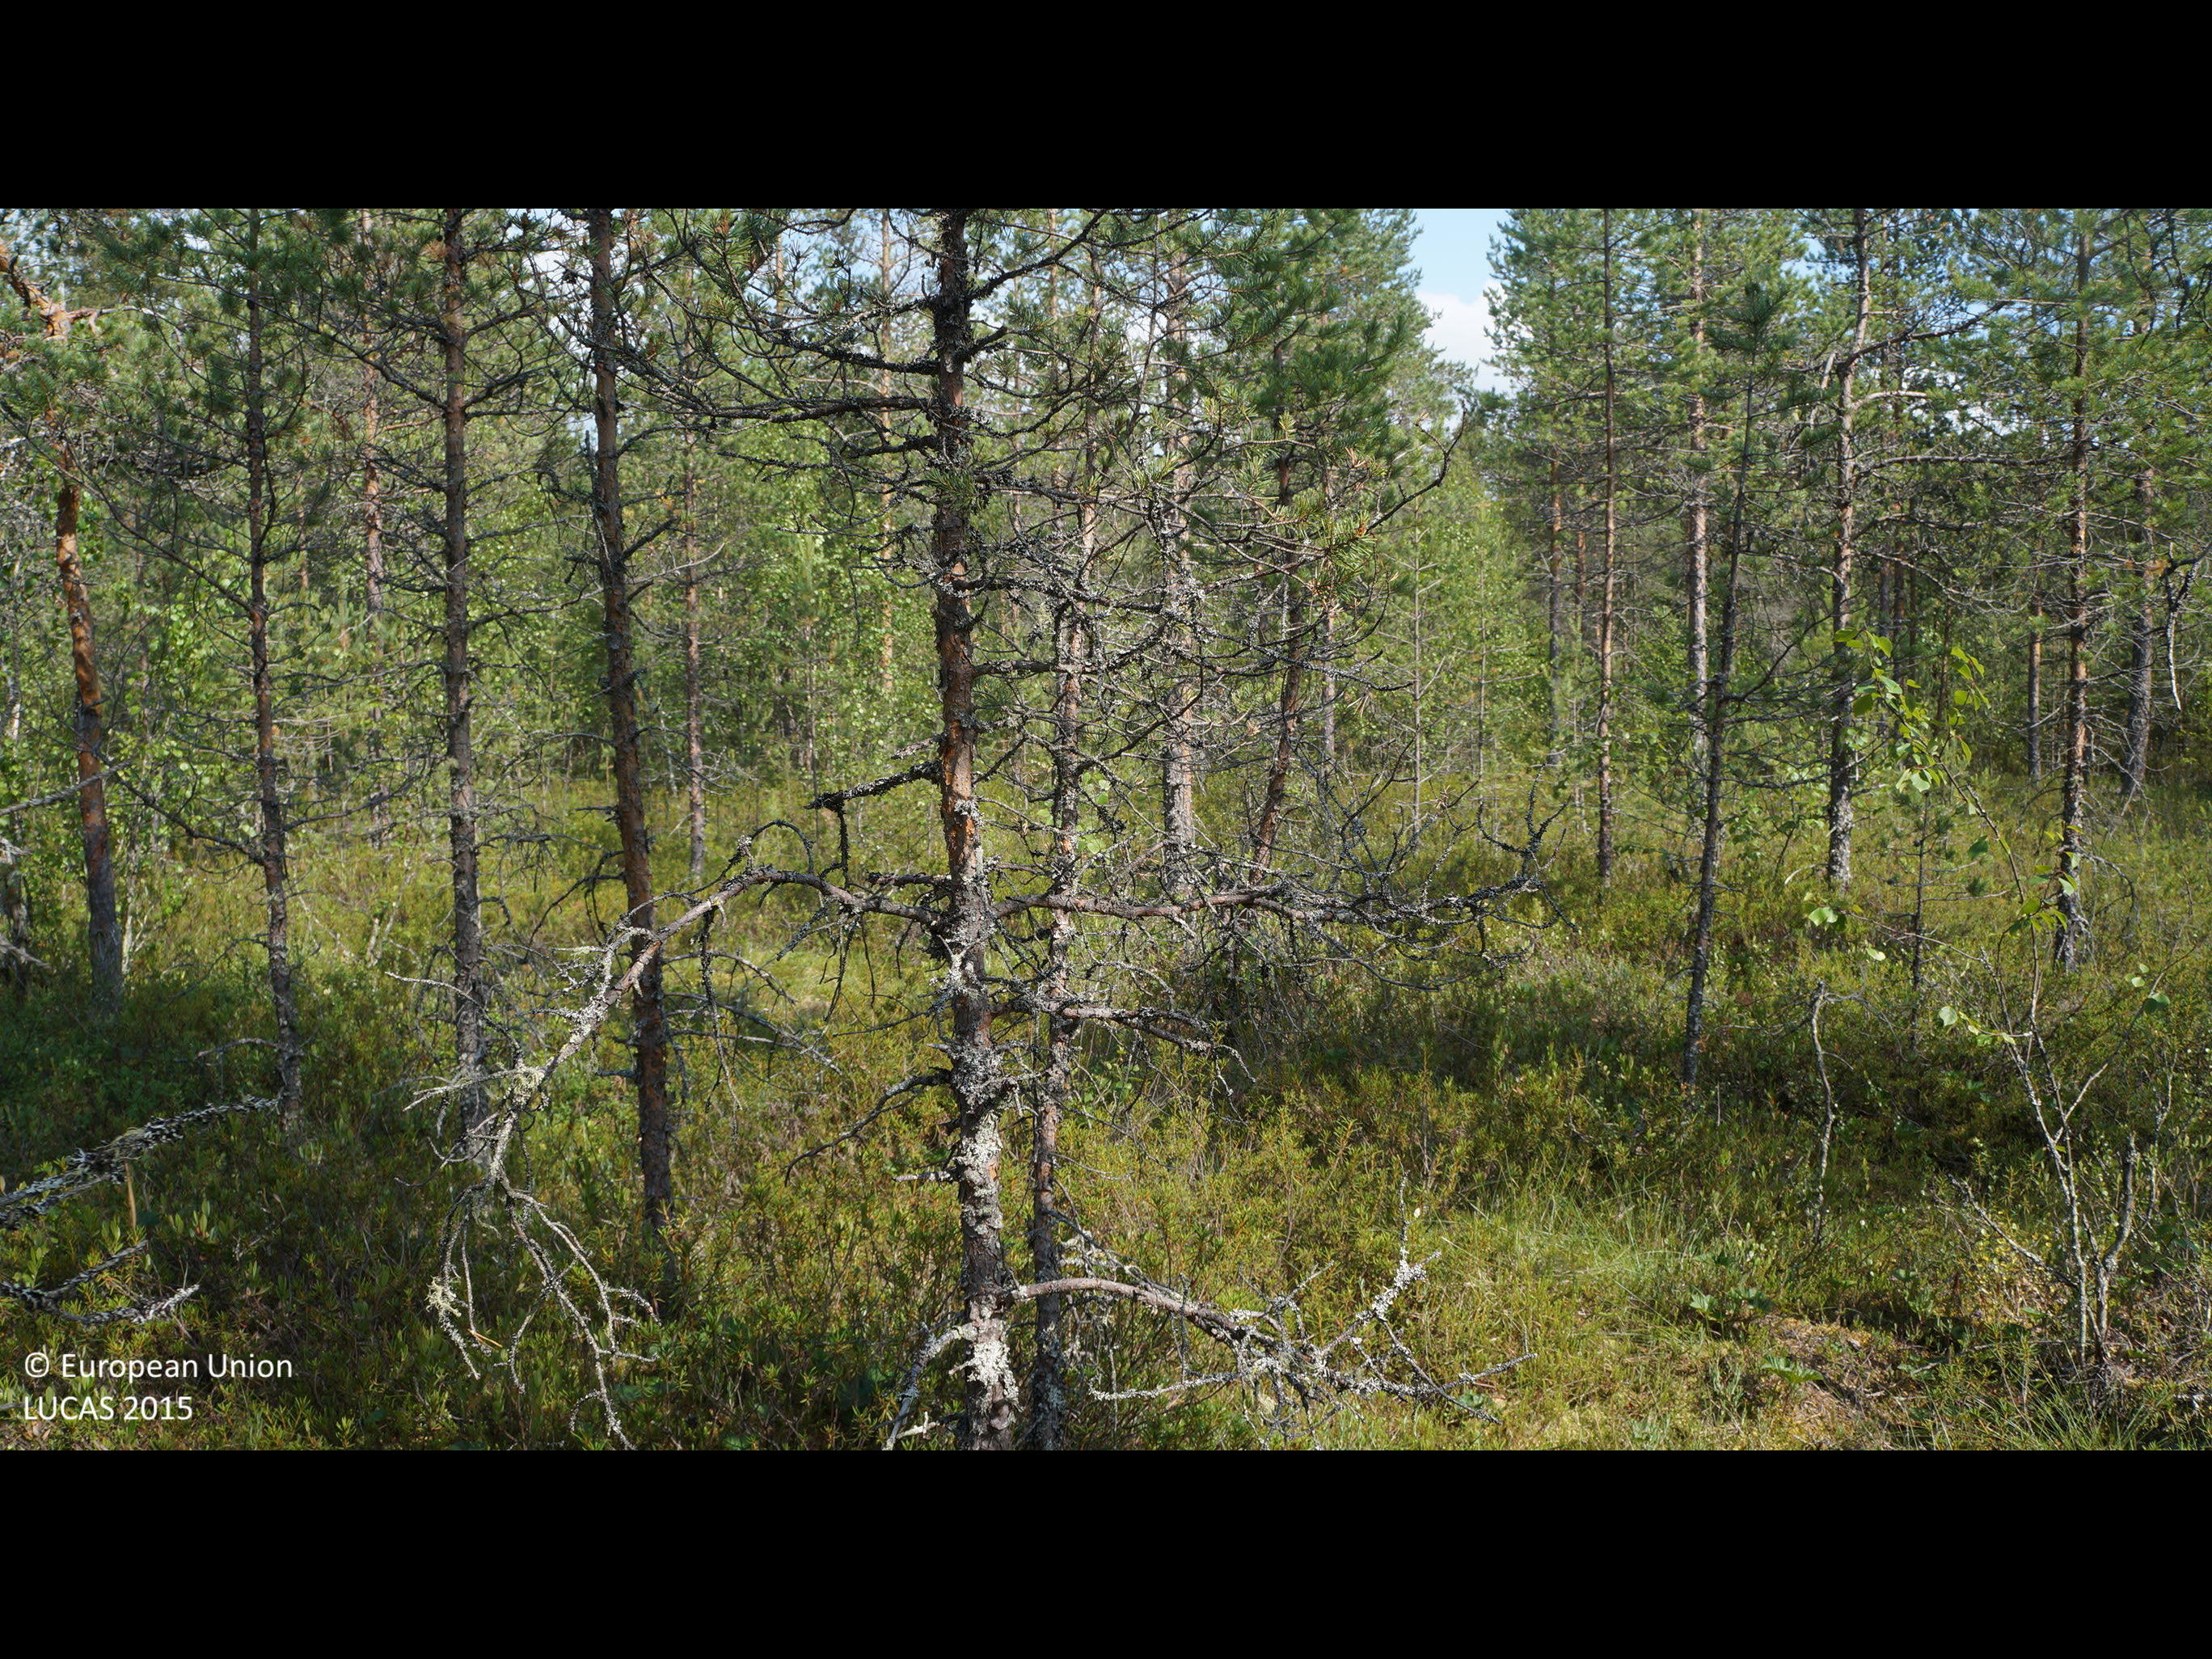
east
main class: Woodland
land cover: Pine dominated coniferous woodland
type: boreal forest
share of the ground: 25 - 50 %
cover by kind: coniferous forest trees 40 %, shrubs 40 %, lichens and mosses 20 %
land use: Forestry
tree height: > 5 m
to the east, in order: Pine dominated coniferous woodland; Ditches and canals; Pine dominated coniferous woodland; Ditches and canals; Pine dominated coniferous woodland; Ditches and canals; Pine dominated mixed woodland; Ditches and canals; Pine dominated coniferous woodland; Pine dominated mixed woodland; Ditches and canals; Pine dominated coniferous woodland; Ditches and canals; Pine dominated coniferous woodland
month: July
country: FI
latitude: 64.4490
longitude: 24.4695
